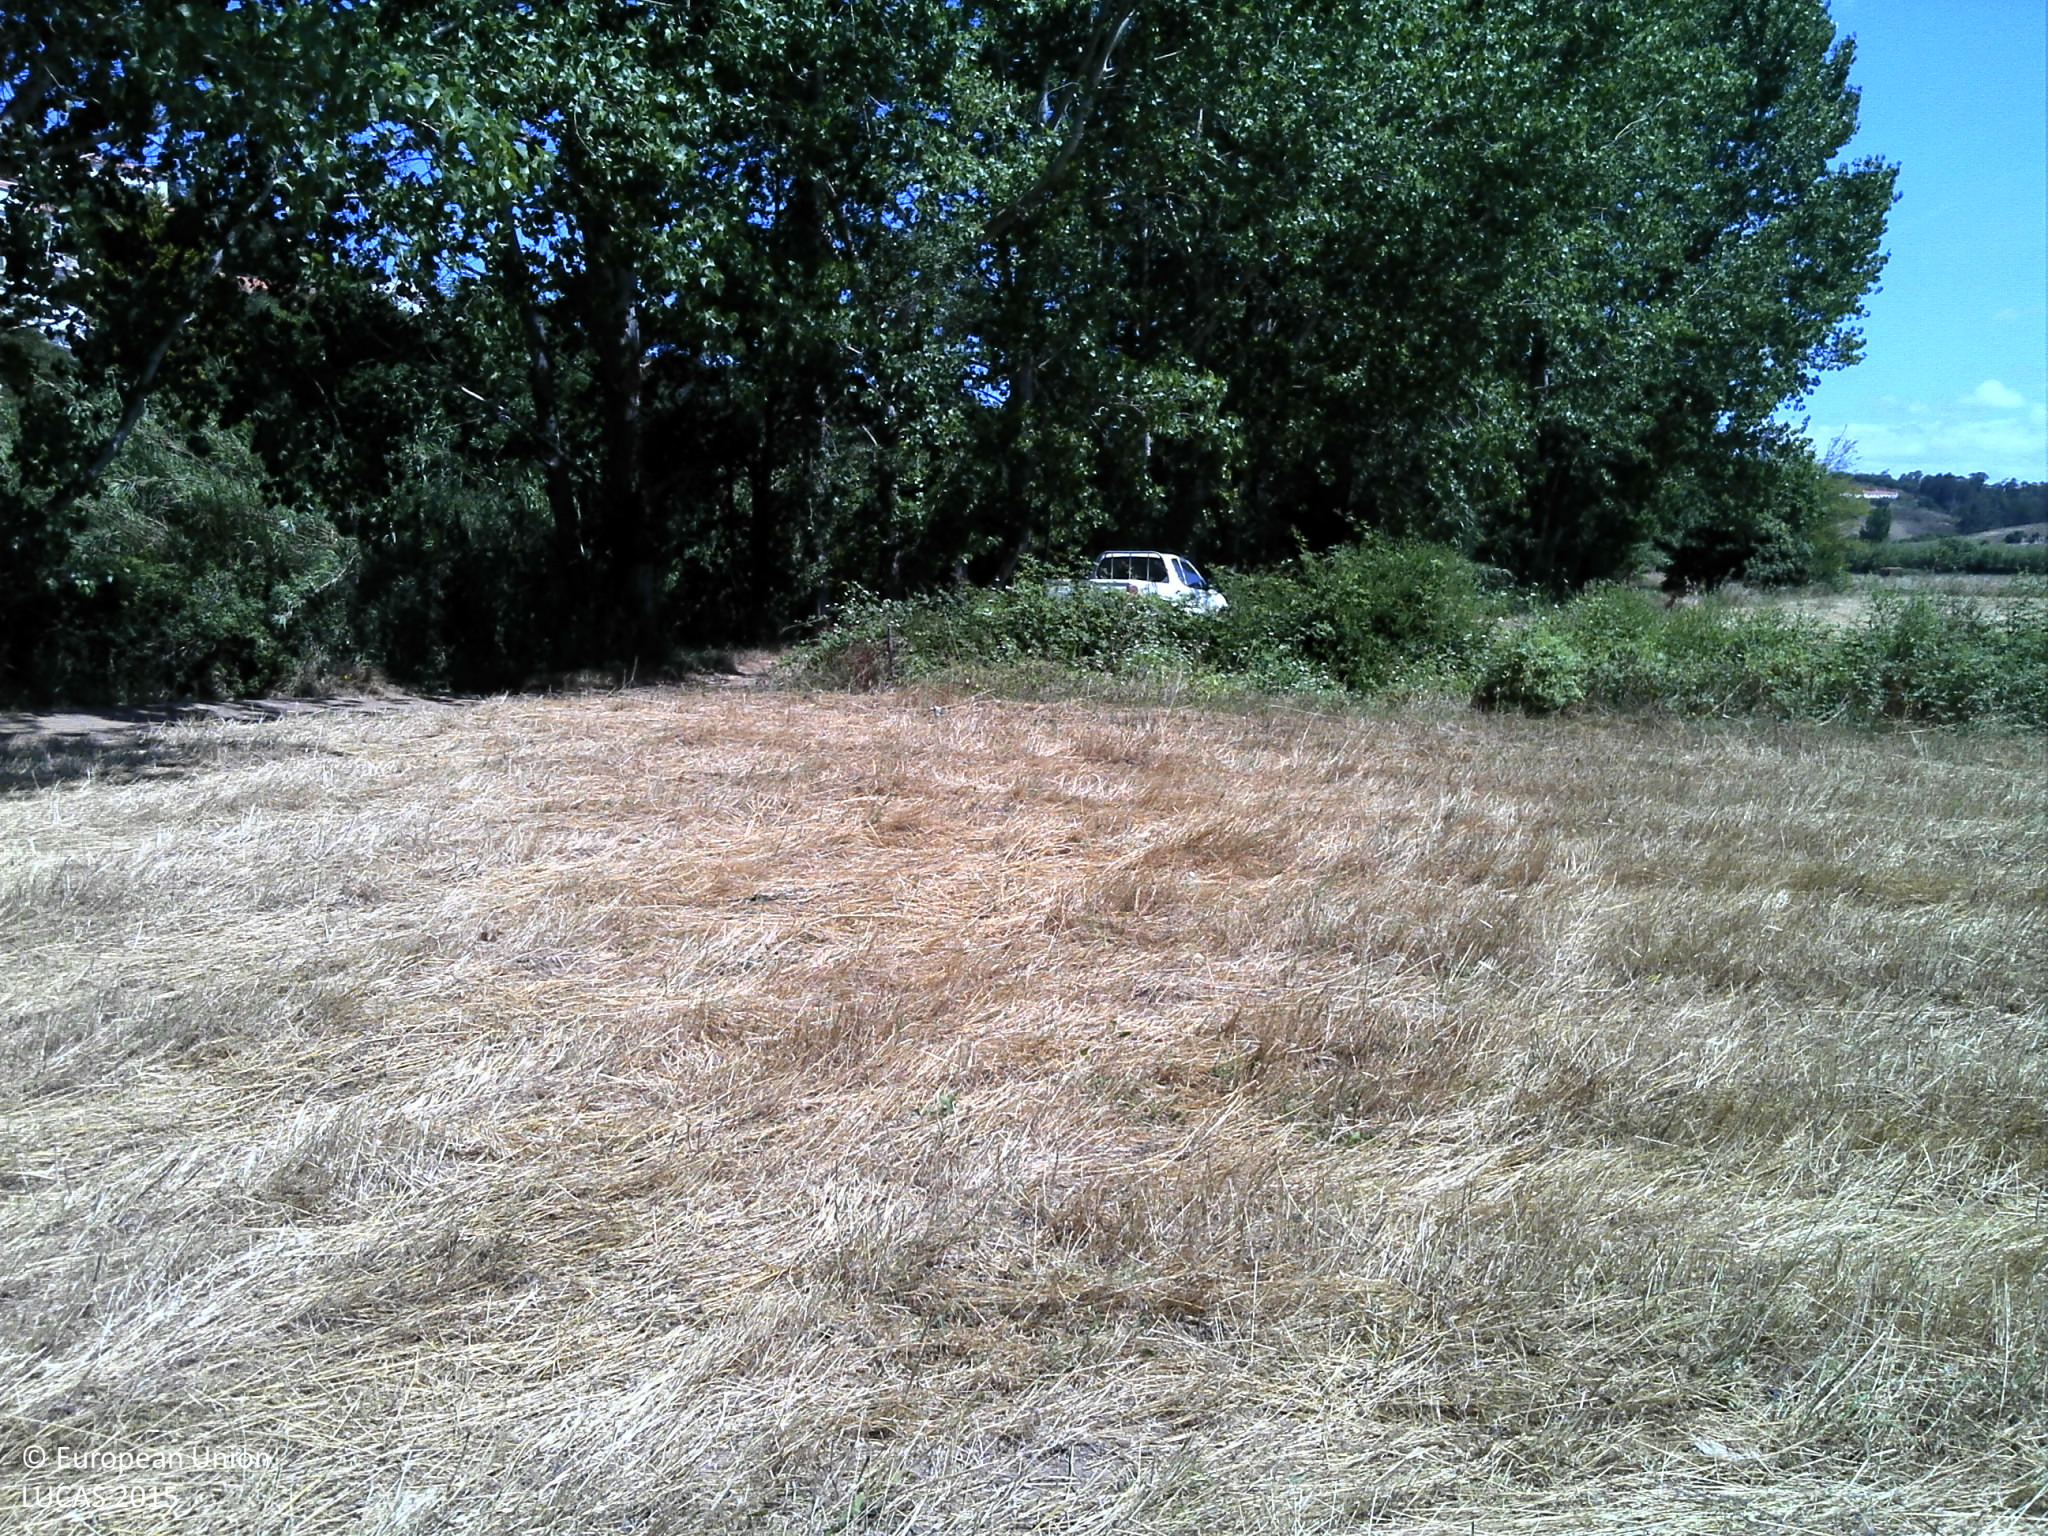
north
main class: Cropland
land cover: Durum wheat
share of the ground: 25 - 50 %
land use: Agriculture (excluding fallow land and kitchen gardens)
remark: Harvested field
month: June
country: PT
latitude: 37.3191
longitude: -8.8020
